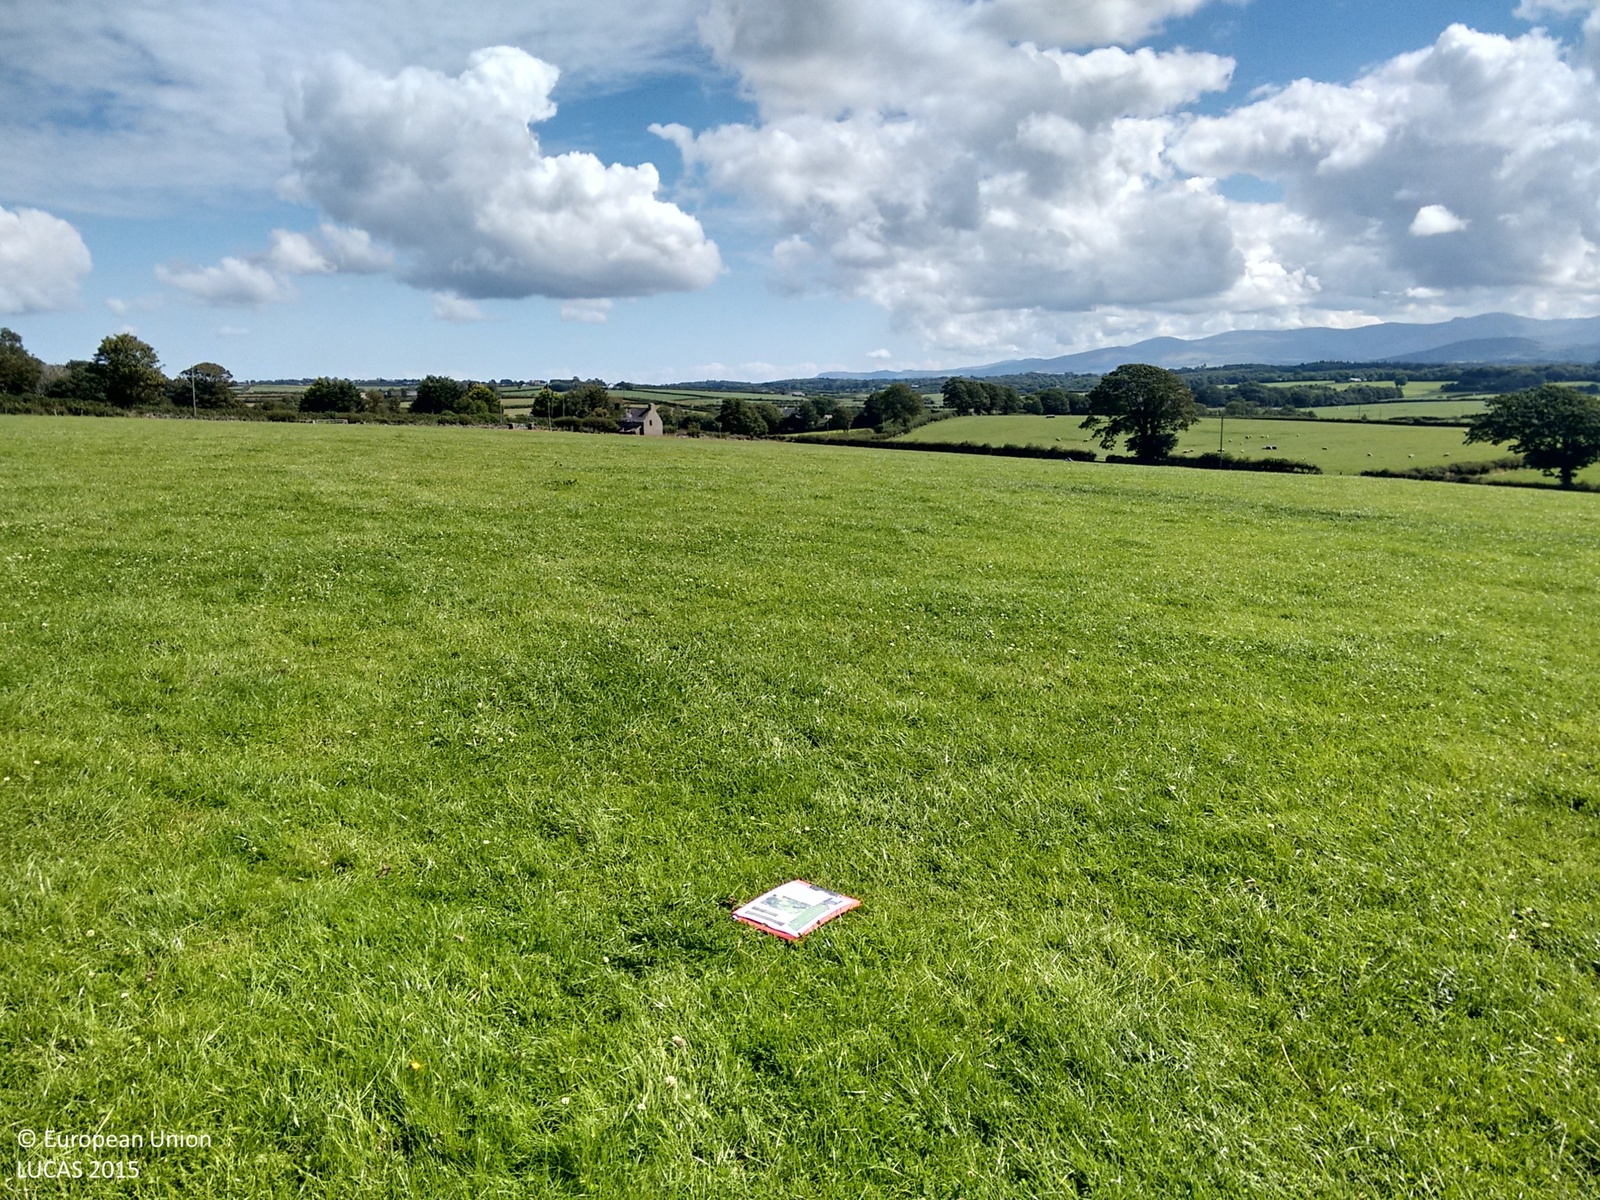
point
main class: Grassland
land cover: Grassland without tree/shrub cover
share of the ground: > 75 %
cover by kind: herbaceous plants 100 %
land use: Agriculture (excluding fallow land and kitchen gardens)
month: August
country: GB
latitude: 53.1865
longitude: -4.3026
